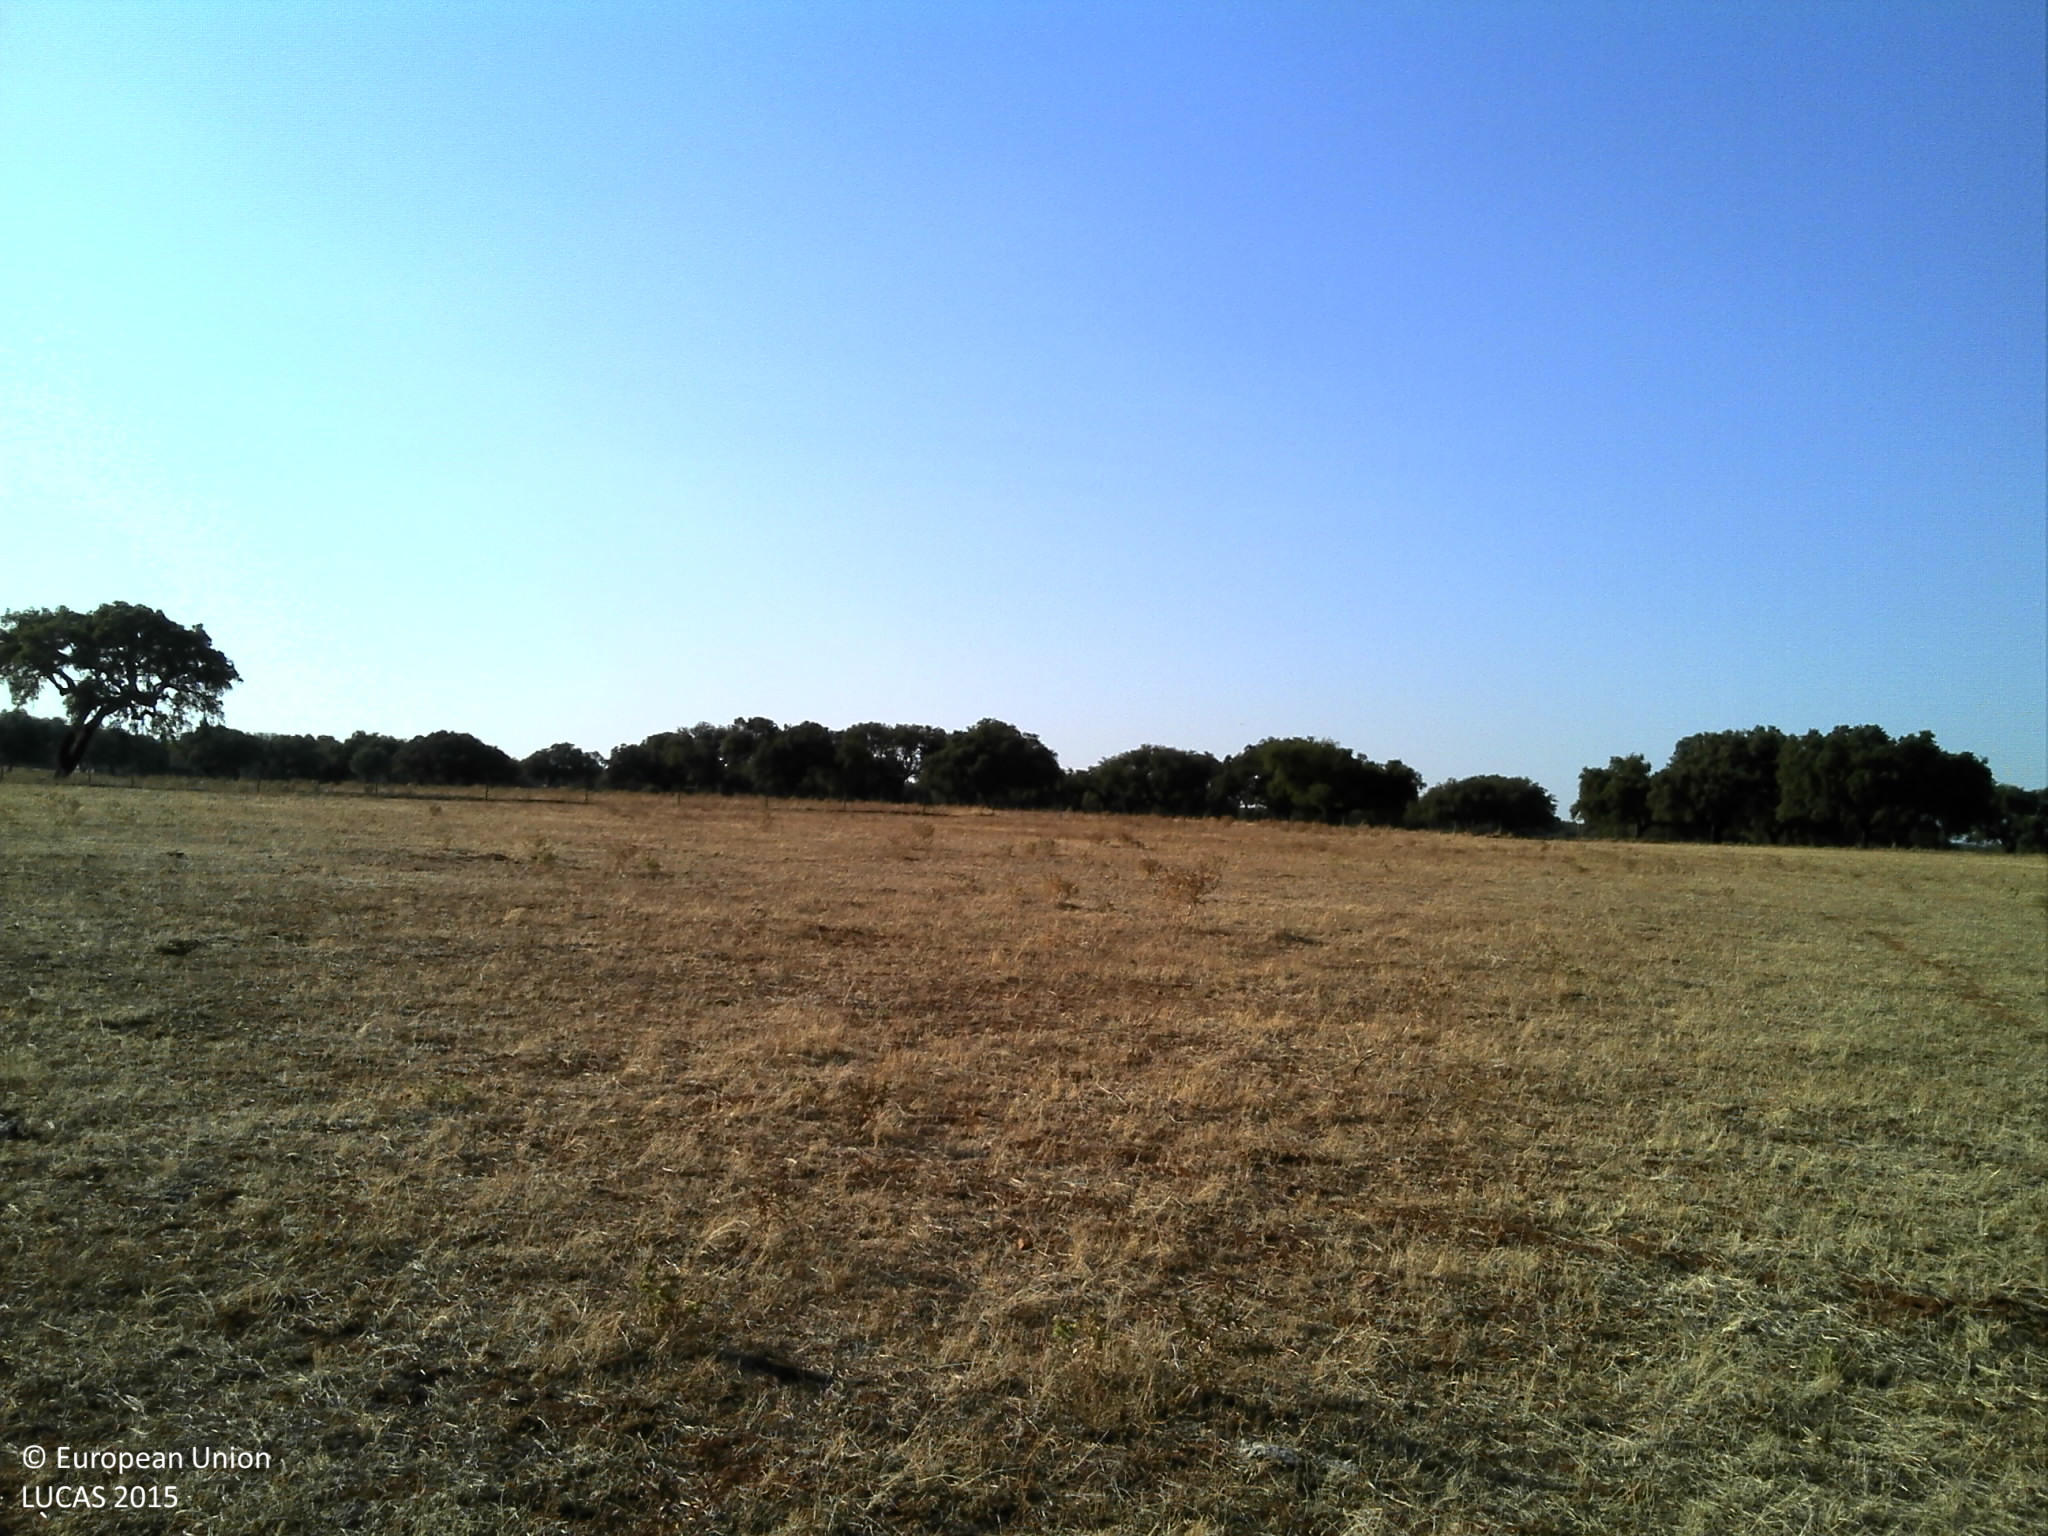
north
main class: Grassland
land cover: Spontaneously vegetated surfaces
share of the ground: 10 - 25 %
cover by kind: unconsolidated bare surface 90 %, herbaceous plants 10 %
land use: Agriculture (excluding fallow land and kitchen gardens)
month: July
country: PT
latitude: 38.5389
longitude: -7.6664
